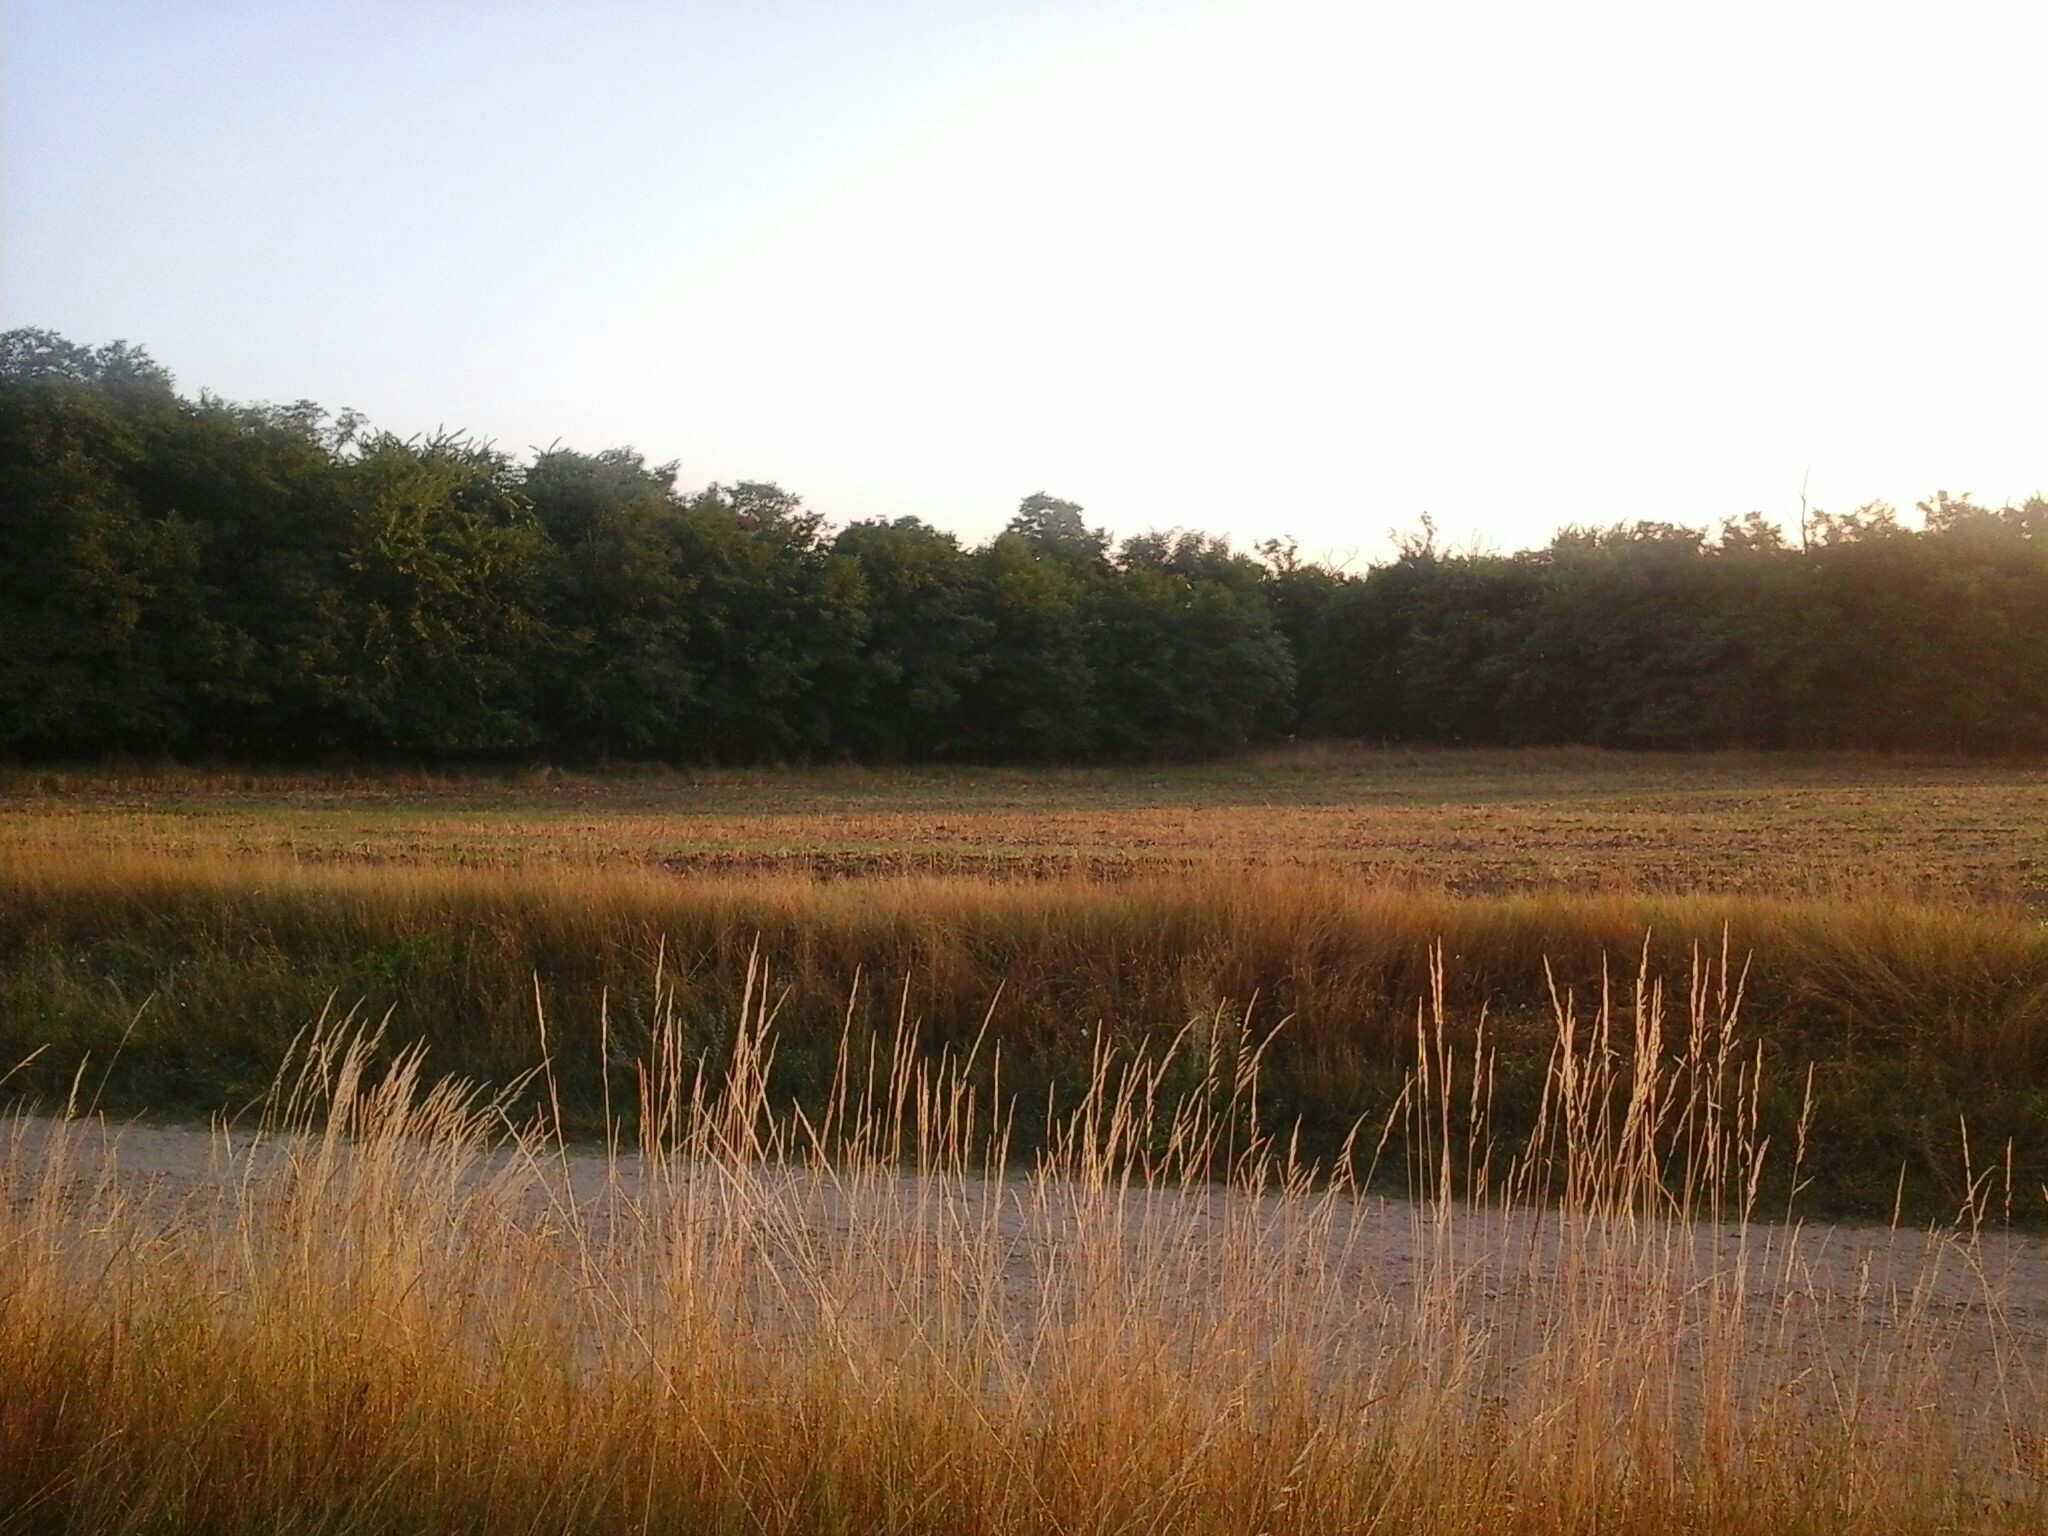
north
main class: Cropland
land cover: Common wheat
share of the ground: < 10 %
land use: Agriculture (excluding fallow land and kitchen gardens)
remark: Harvested field
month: August
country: HU
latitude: 47.6703
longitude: 18.1228
